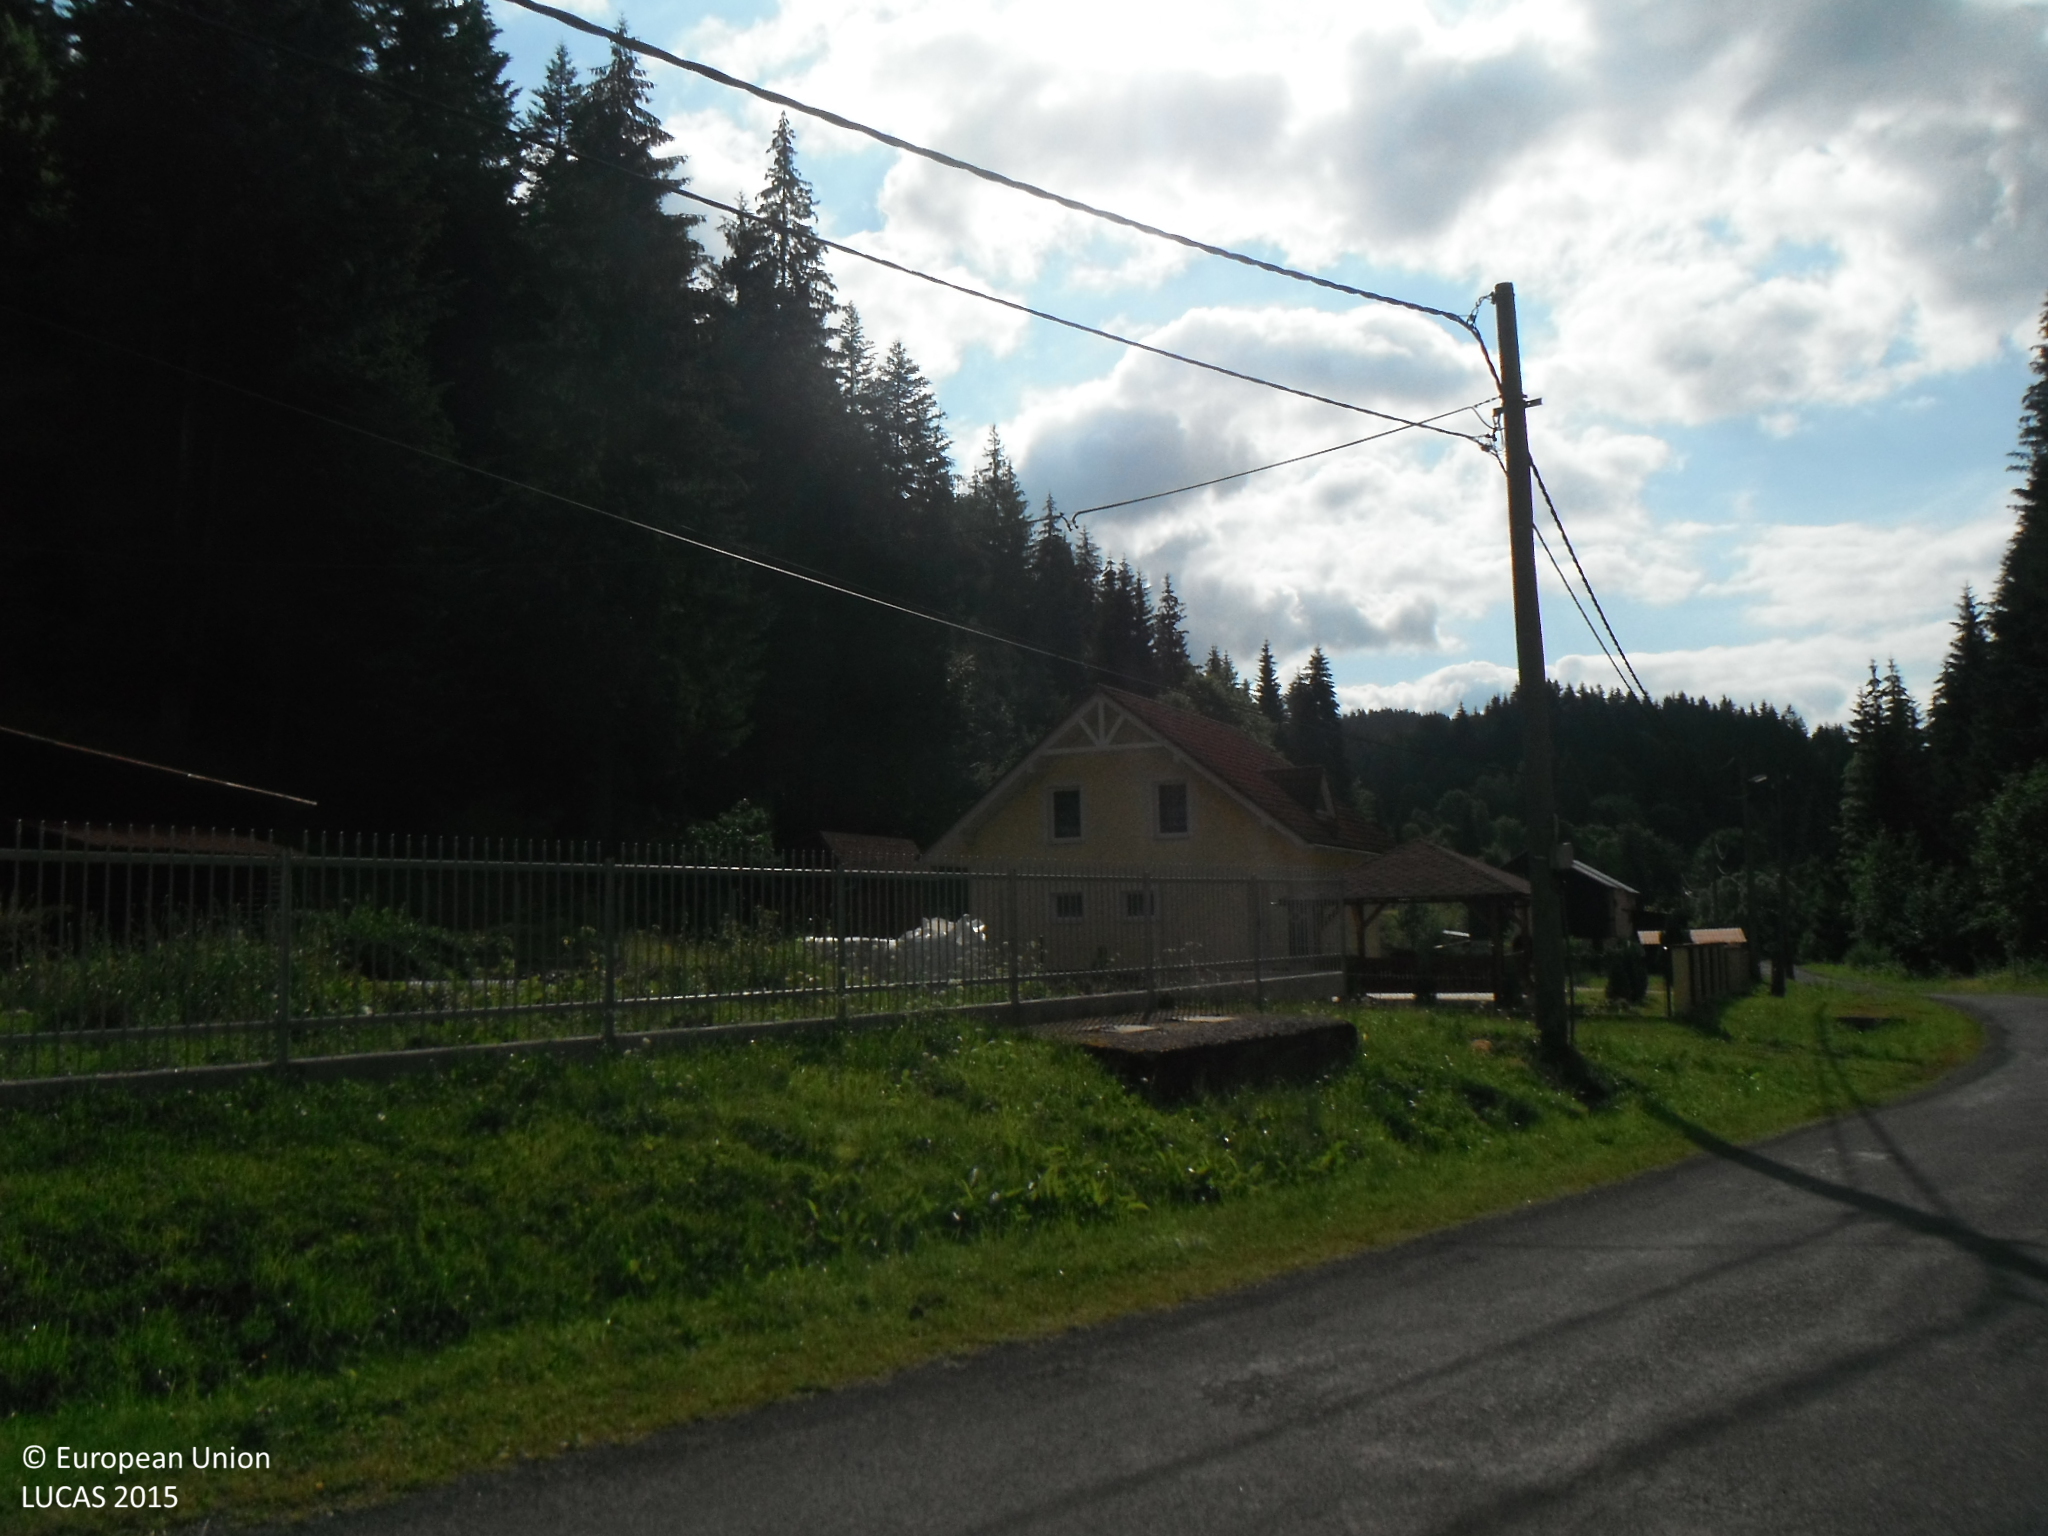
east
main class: Grassland
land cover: Grassland without tree/shrub cover
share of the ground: > 75 %
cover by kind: herbaceous plants 95 %
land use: Residential
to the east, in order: Grassland without tree/shrub cover; Artificial constructions in urban areas; Spontaneously vegetated surfaces; Shrubland with sparse tree cover; Broadleaved woodland; Spruce dominated coniferous woodland; Spruce dominated mixed woodland
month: July
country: SK
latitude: 49.4304
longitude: 18.5260
